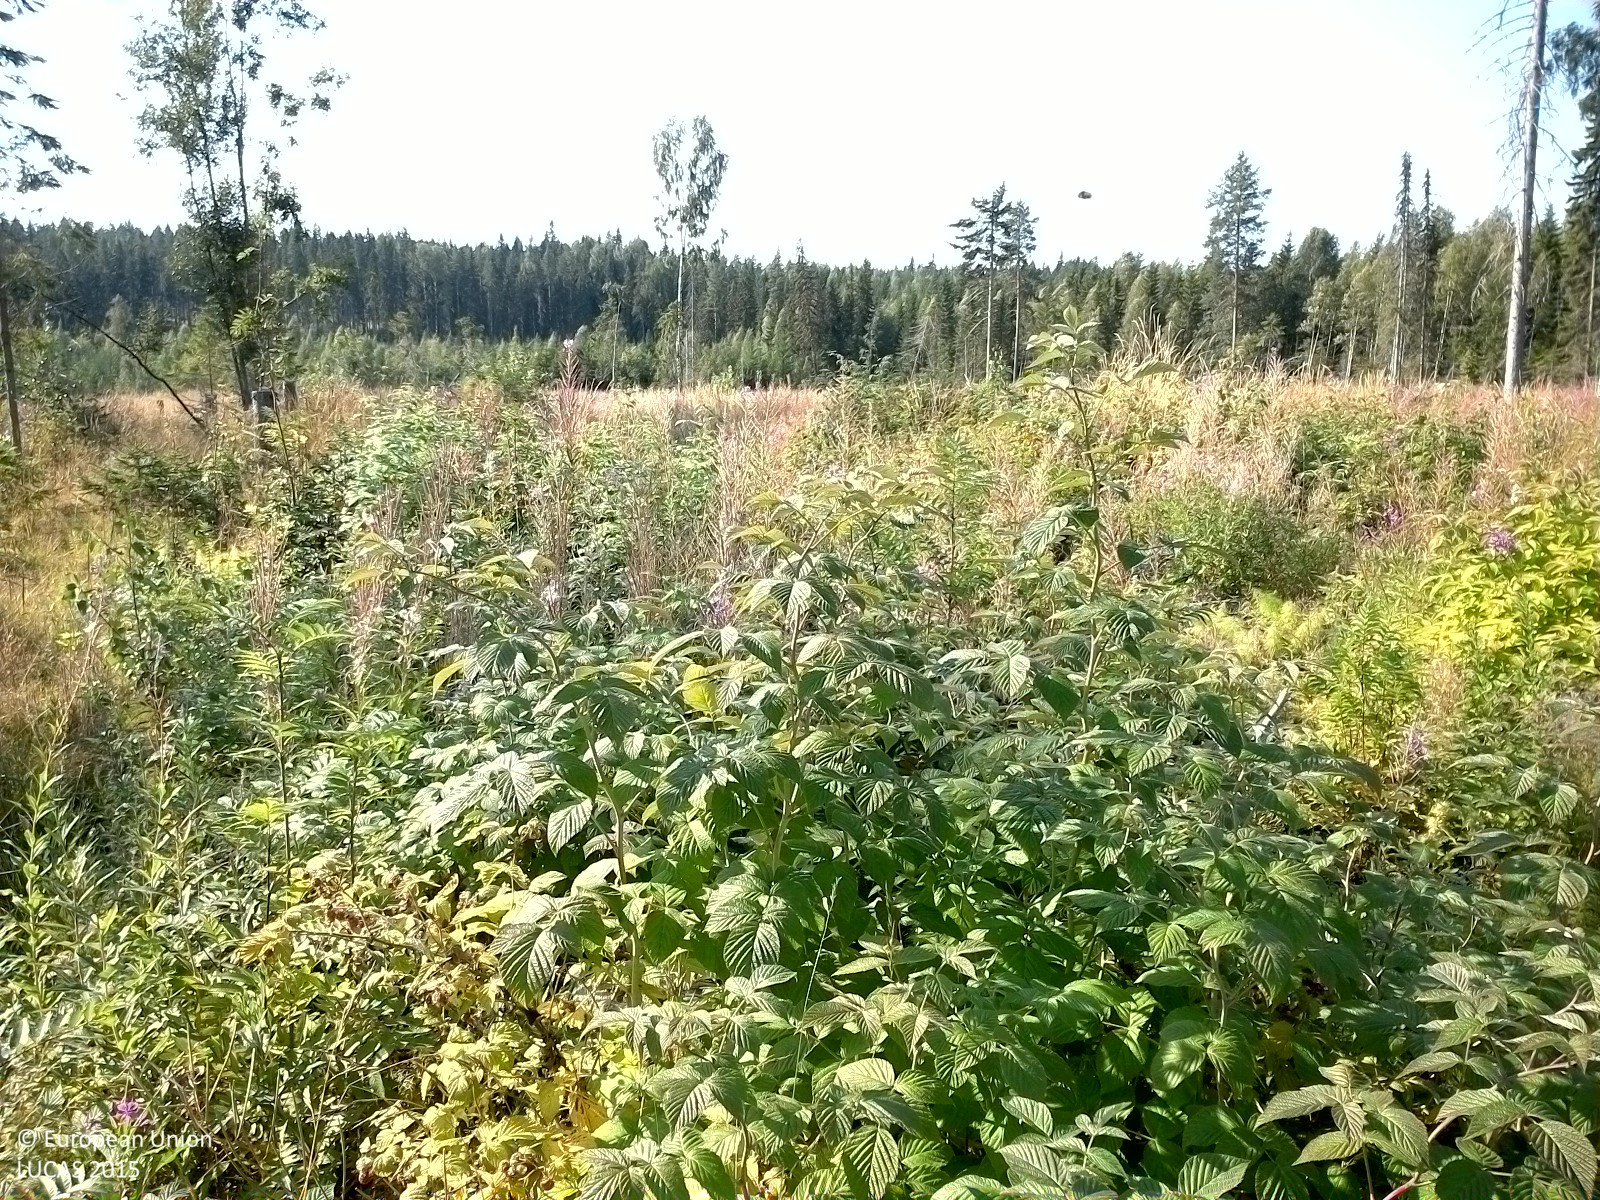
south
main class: Woodland
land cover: Spruce dominated mixed woodland
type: boreal forest
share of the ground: 10 - 25 %
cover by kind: herbaceous plants 50 %, shrubs 30 %, coniferous forest trees 10 %, broadleaved forest trees 10 %
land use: Forestry
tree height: < 5 m
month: August
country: SE
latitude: 62.4616
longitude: 16.3191
